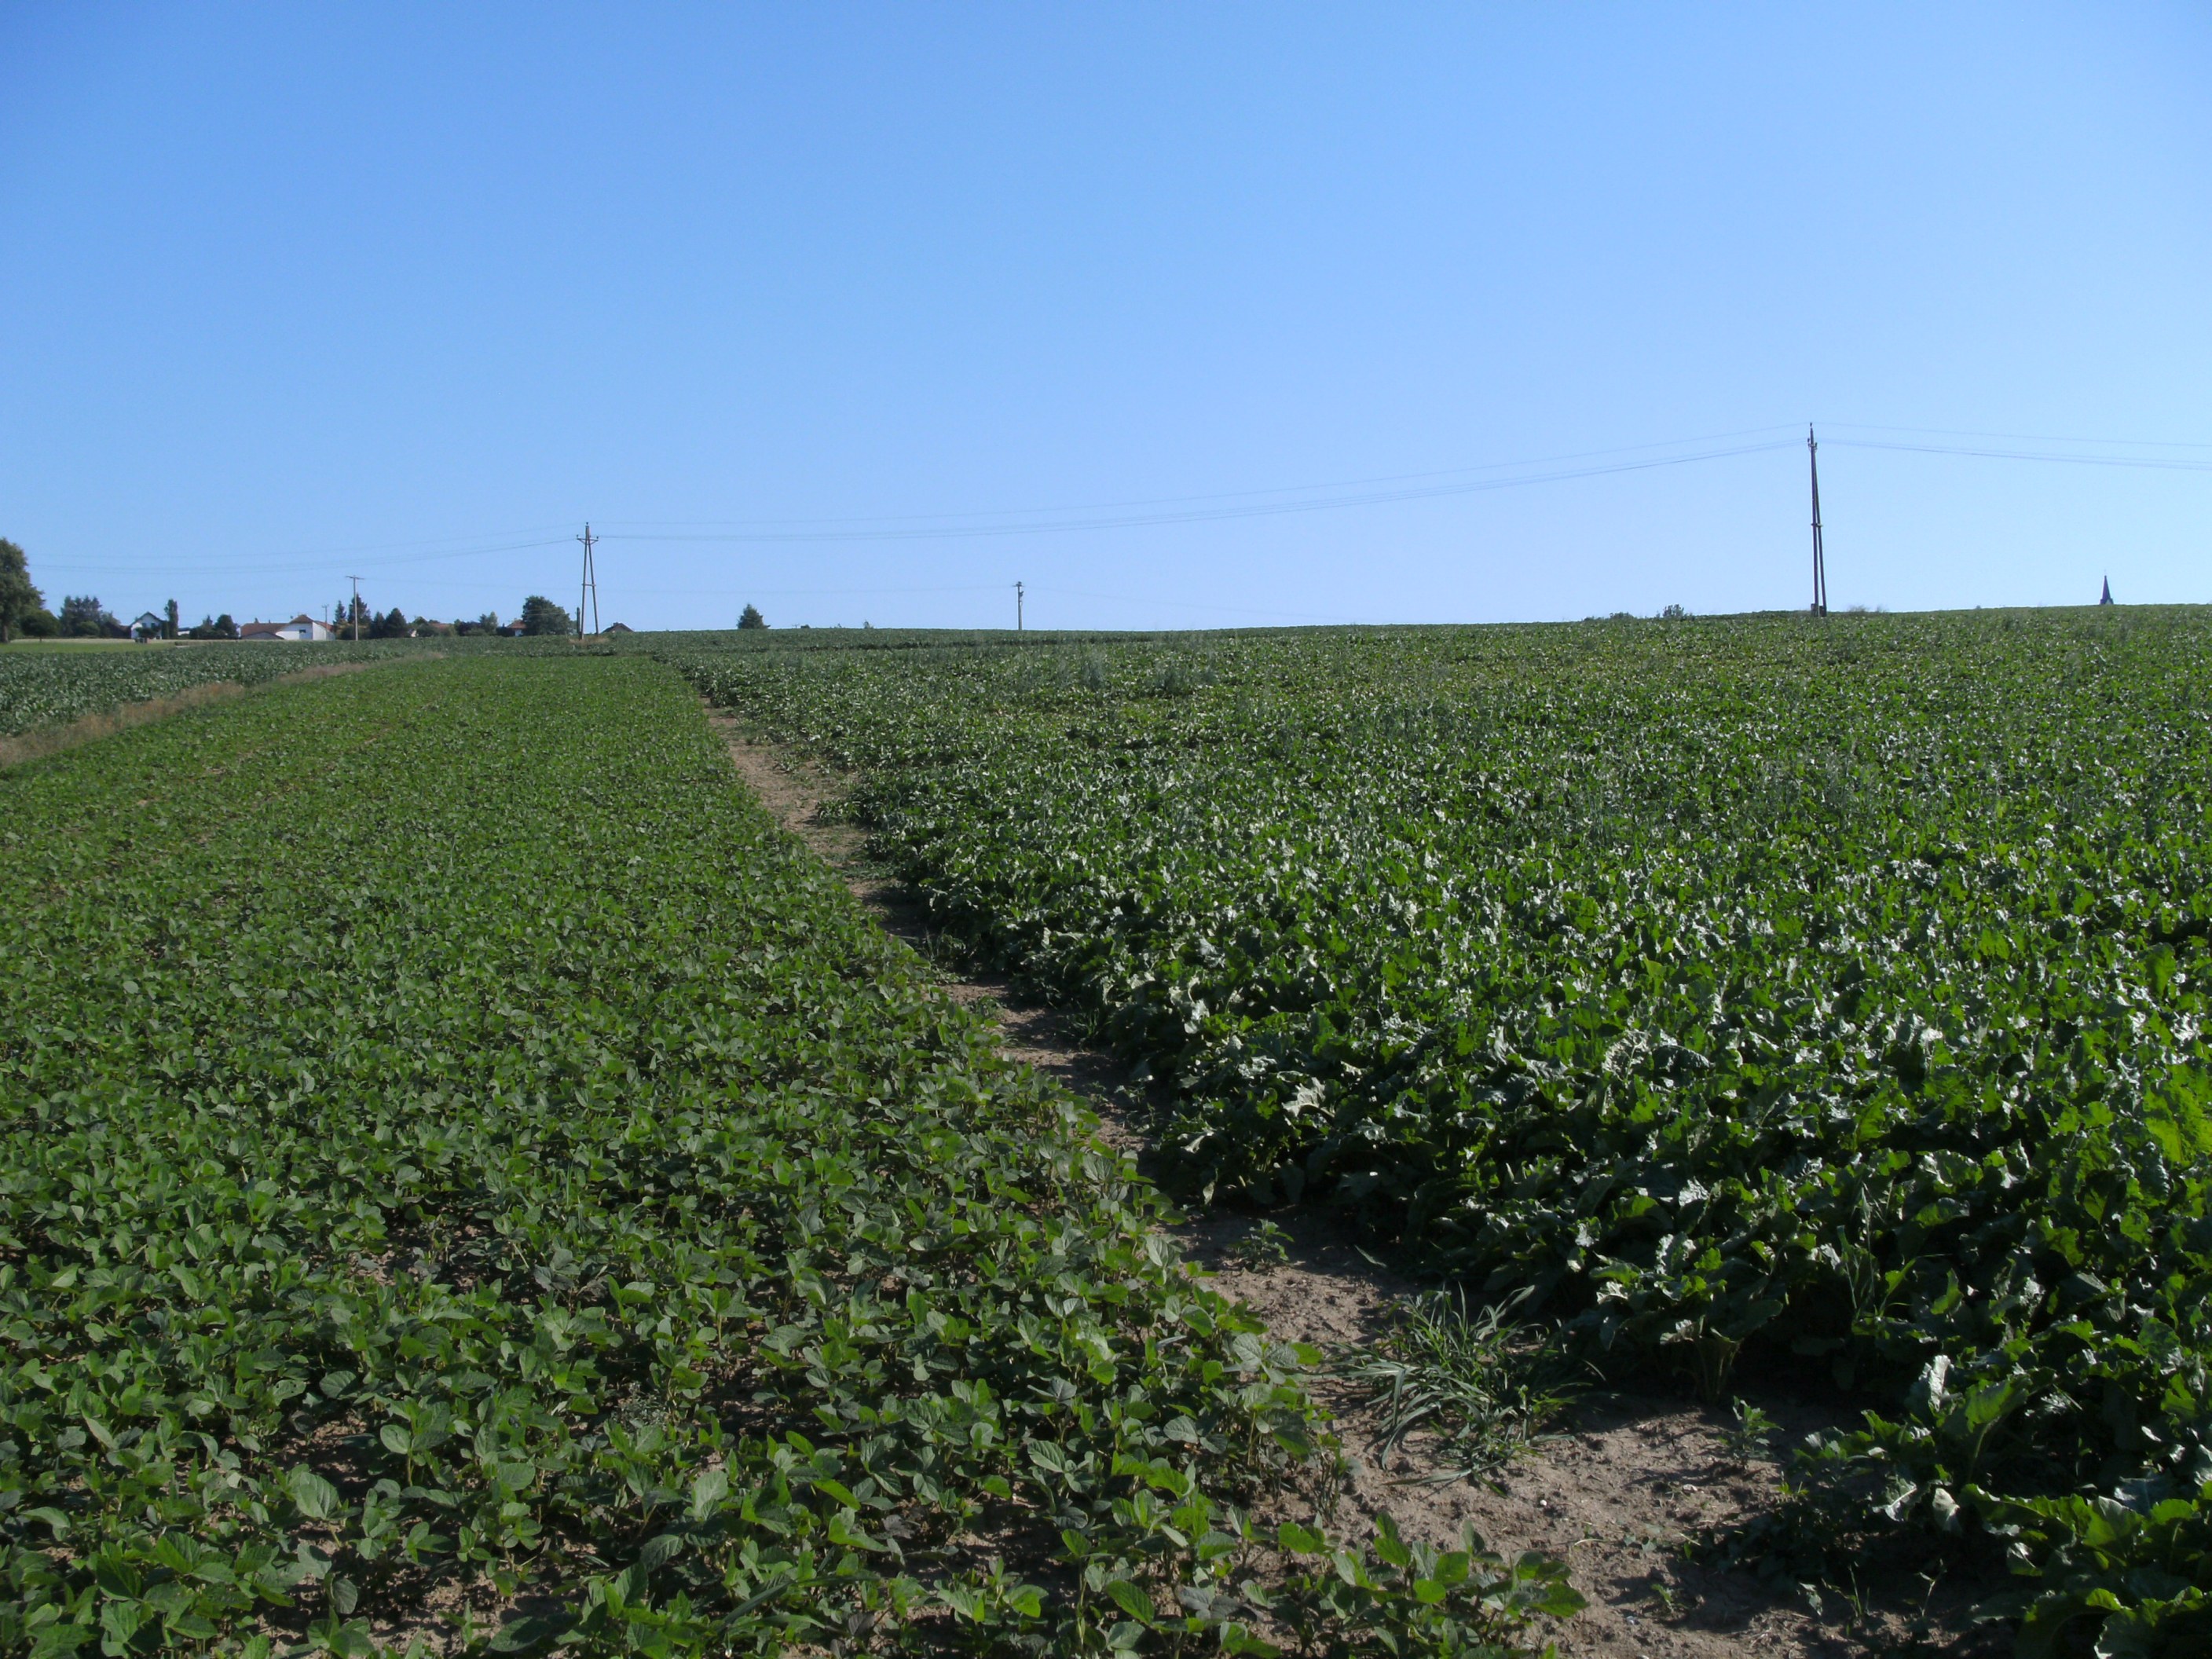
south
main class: Cropland
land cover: Soya
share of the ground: > 75 %
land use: Agriculture (excluding fallow land and kitchen gardens)
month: July
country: AT
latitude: 48.2711
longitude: 14.1632
